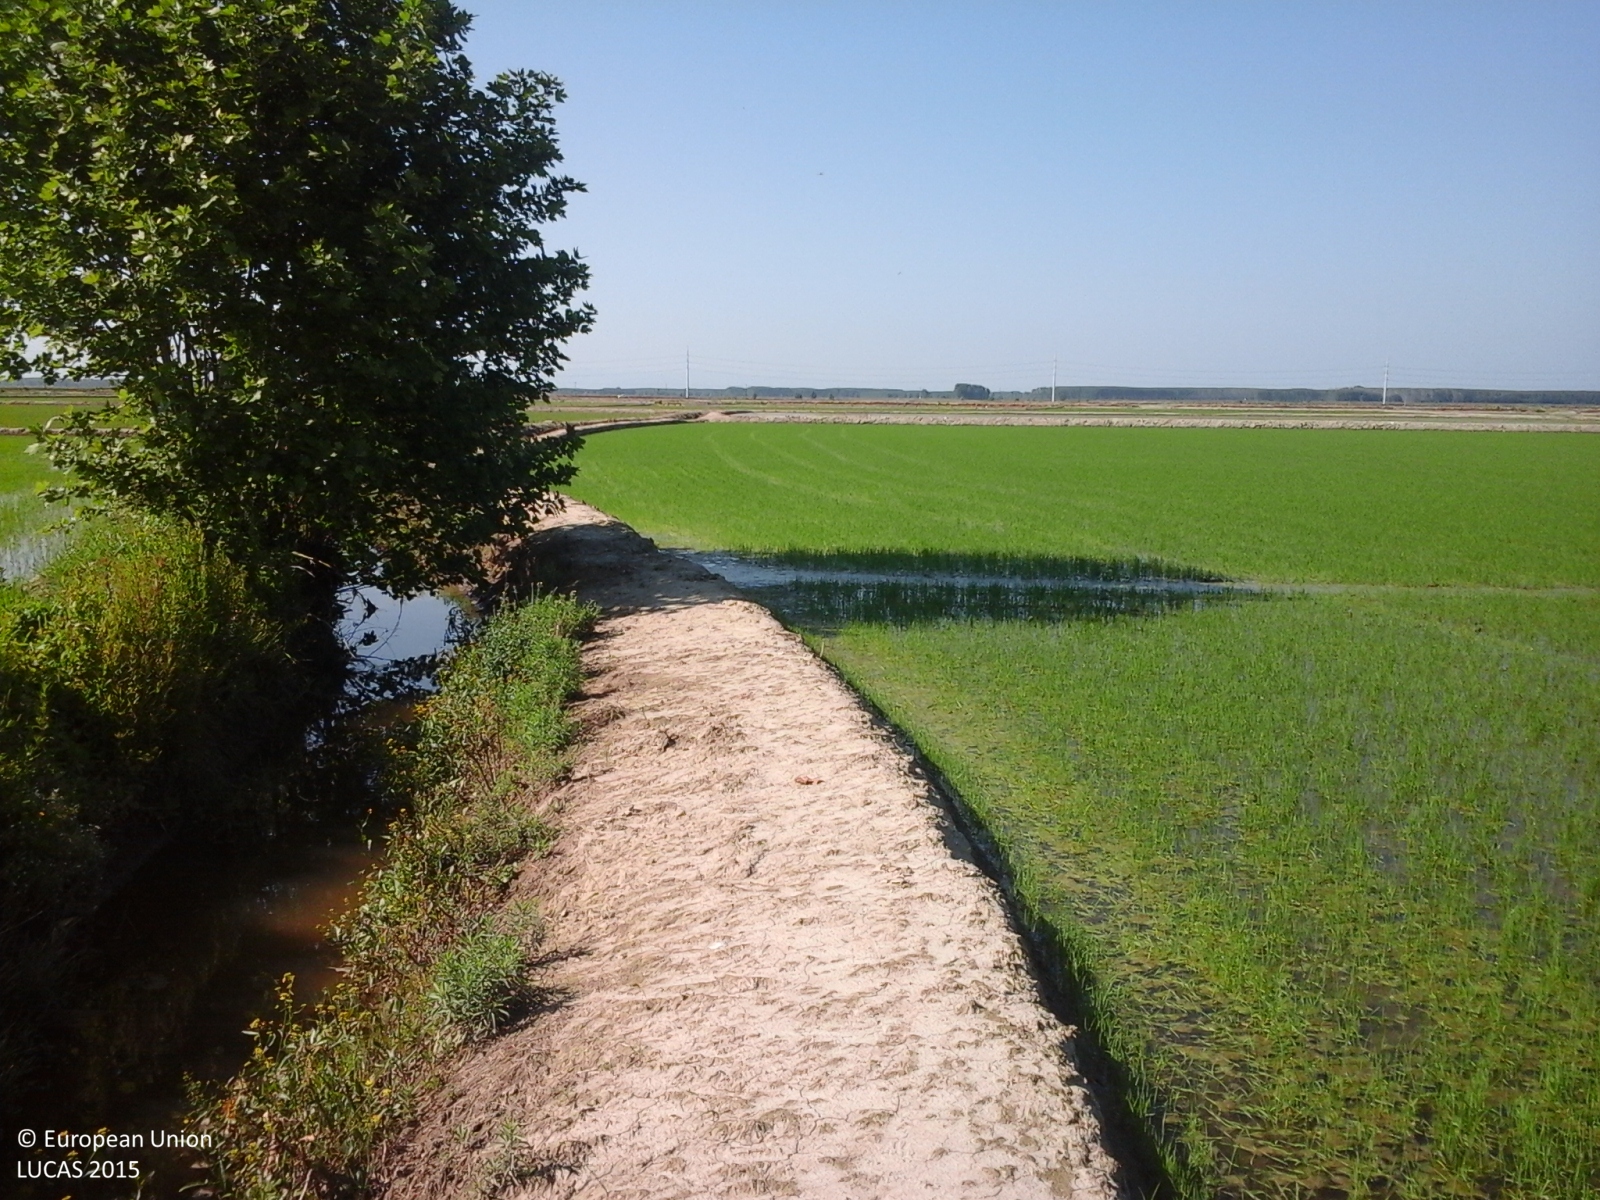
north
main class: Cropland
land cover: Rice
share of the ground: 50 - 75 %
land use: Agriculture (excluding fallow land and kitchen gardens)
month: May
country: IT
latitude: 45.2596
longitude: 8.5116
